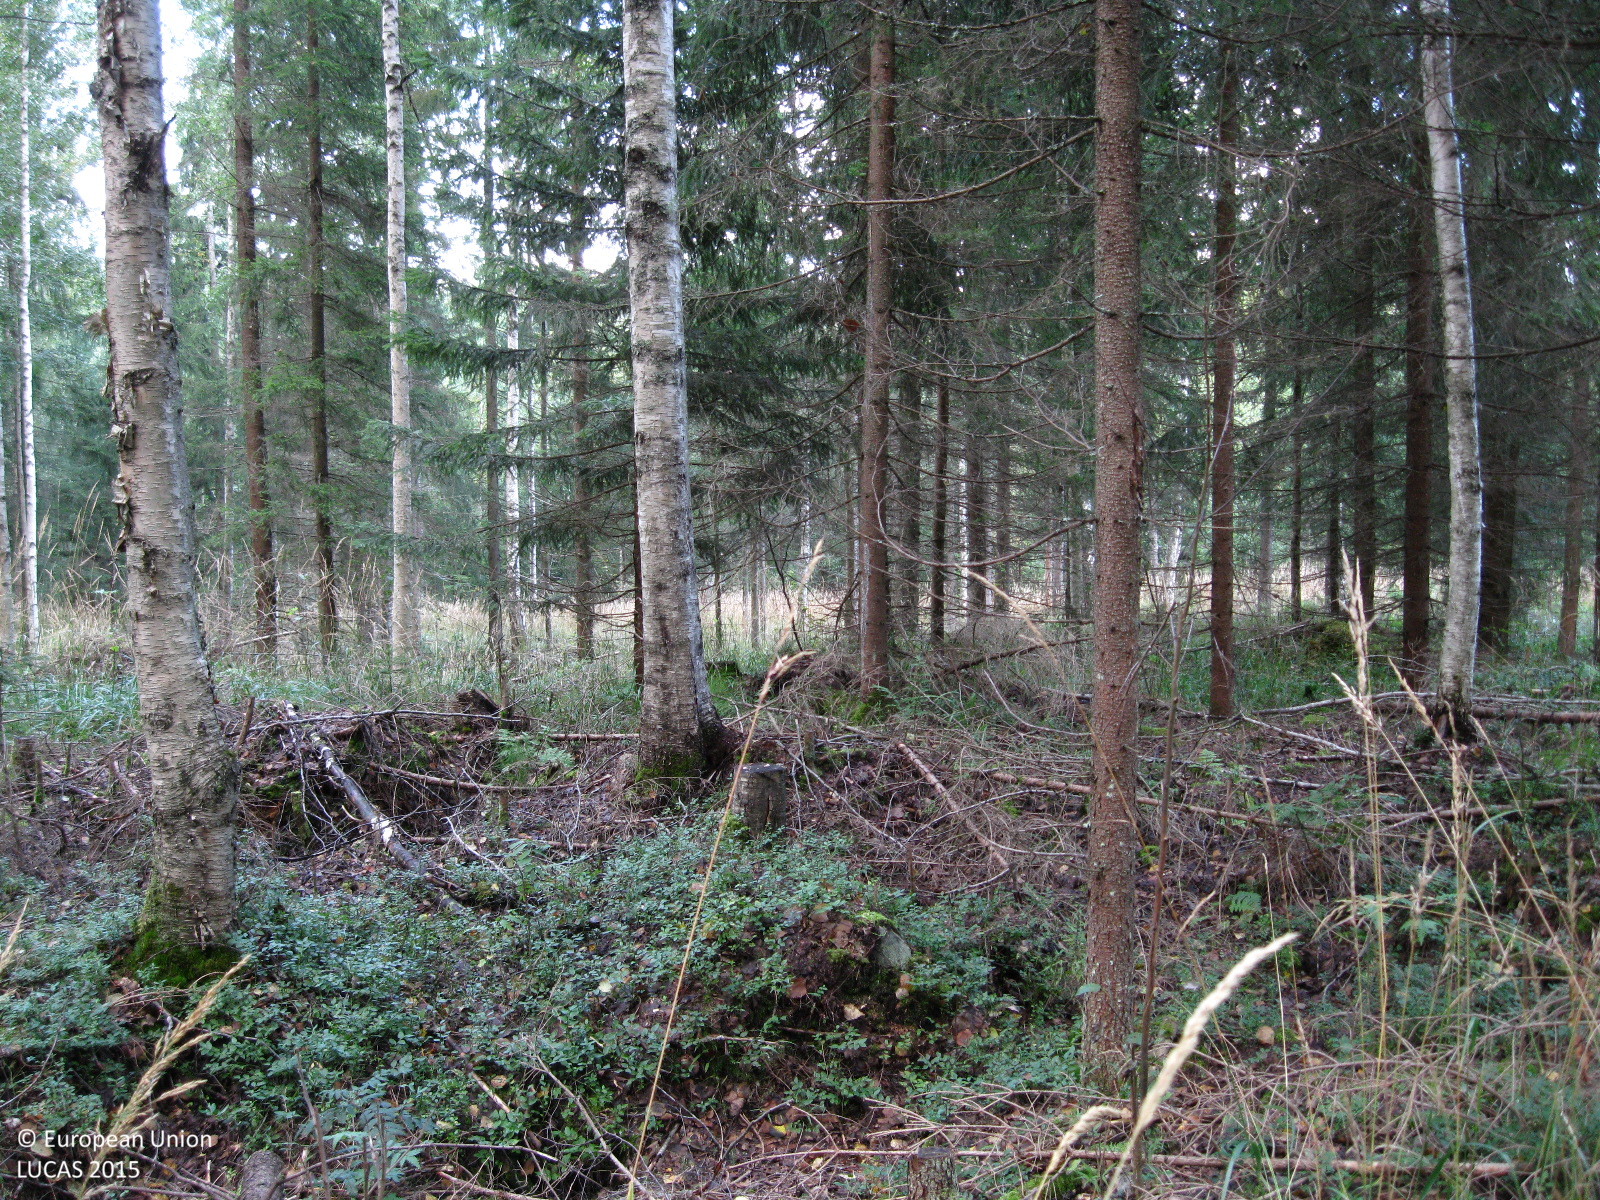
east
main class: Woodland
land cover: Spruce dominated mixed woodland
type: boreal forest
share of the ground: 50 - 75 %
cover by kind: coniferous forest trees 40 %, broadleaved forest trees 30 %, shrubs 20 %, herbaceous plants 10 %
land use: Forestry
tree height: > 5 m
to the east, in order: Spruce dominated mixed woodland; Grassland without tree/shrub cover; Spruce dominated mixed woodland; Ditches and canals; Spruce dominated mixed woodland; Ditches and canals; Spruce dominated mixed woodland; Ditches and canals; Spruce dominated mixed woodland; Ditches and canals; Broadleaved woodland; Ditches and canals; Broadleaved woodland; Ditches and canals; Broadleaved woodland; Ditches and canals; Other mixed woodland
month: September
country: FI
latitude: 60.6670
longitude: 24.9187
